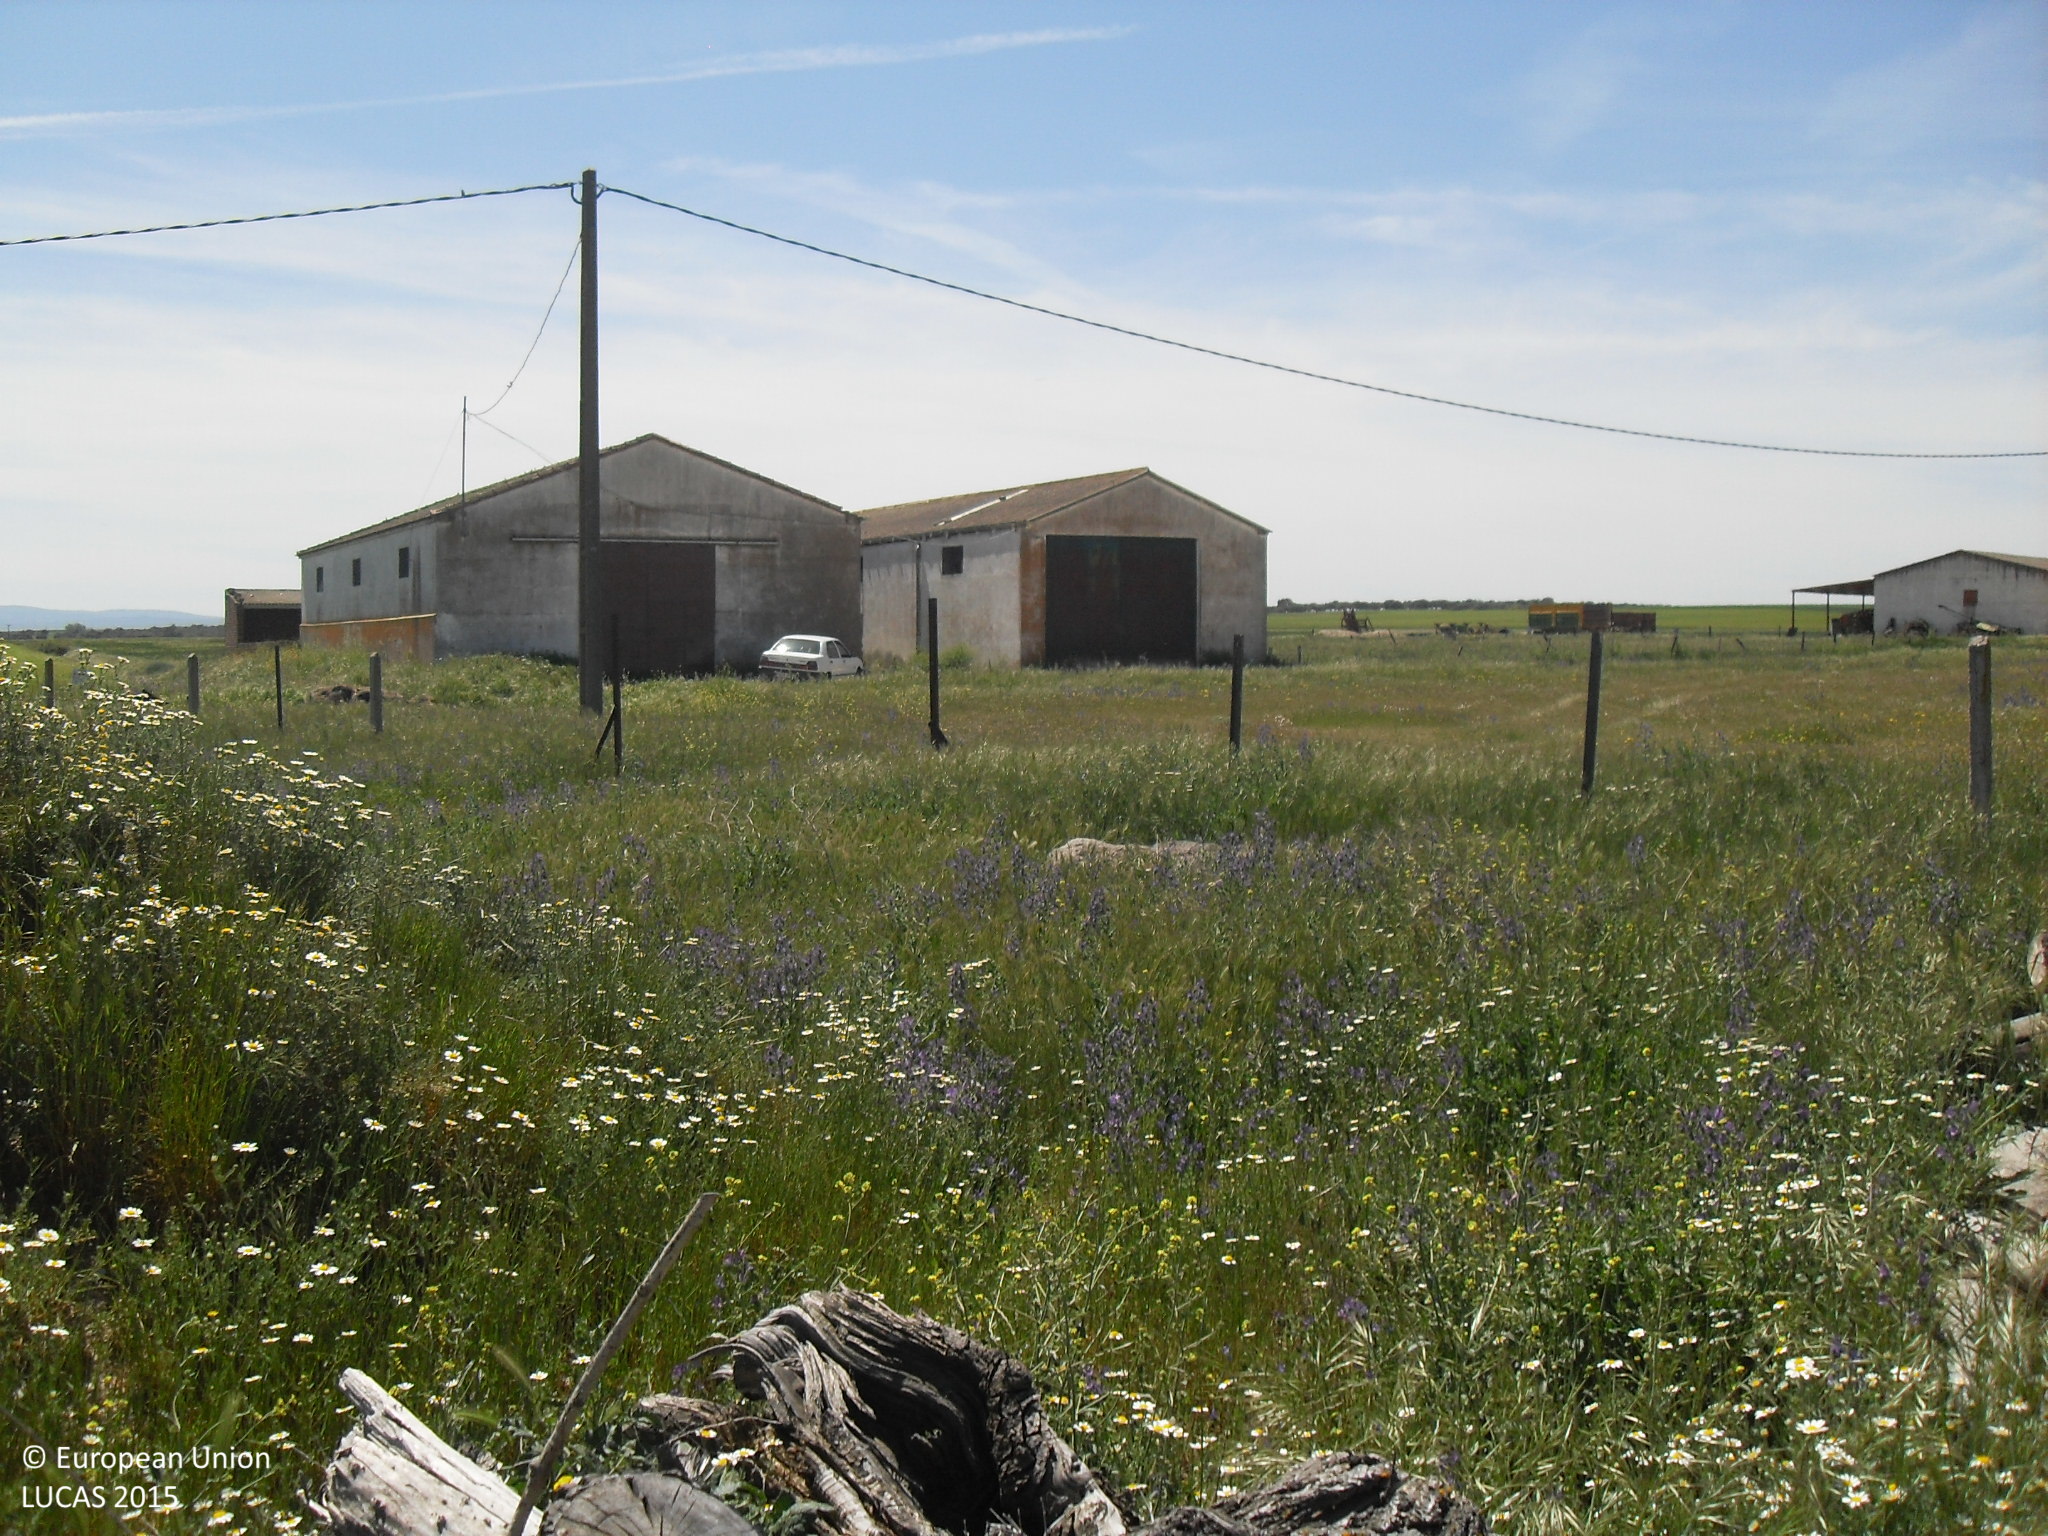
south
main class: Grassland
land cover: Grassland without tree/shrub cover
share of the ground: > 75 %
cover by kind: herbaceous plants 100 %
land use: Agriculture (excluding fallow land and kitchen gardens)
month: May
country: ES
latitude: 40.8503
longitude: -5.3595
